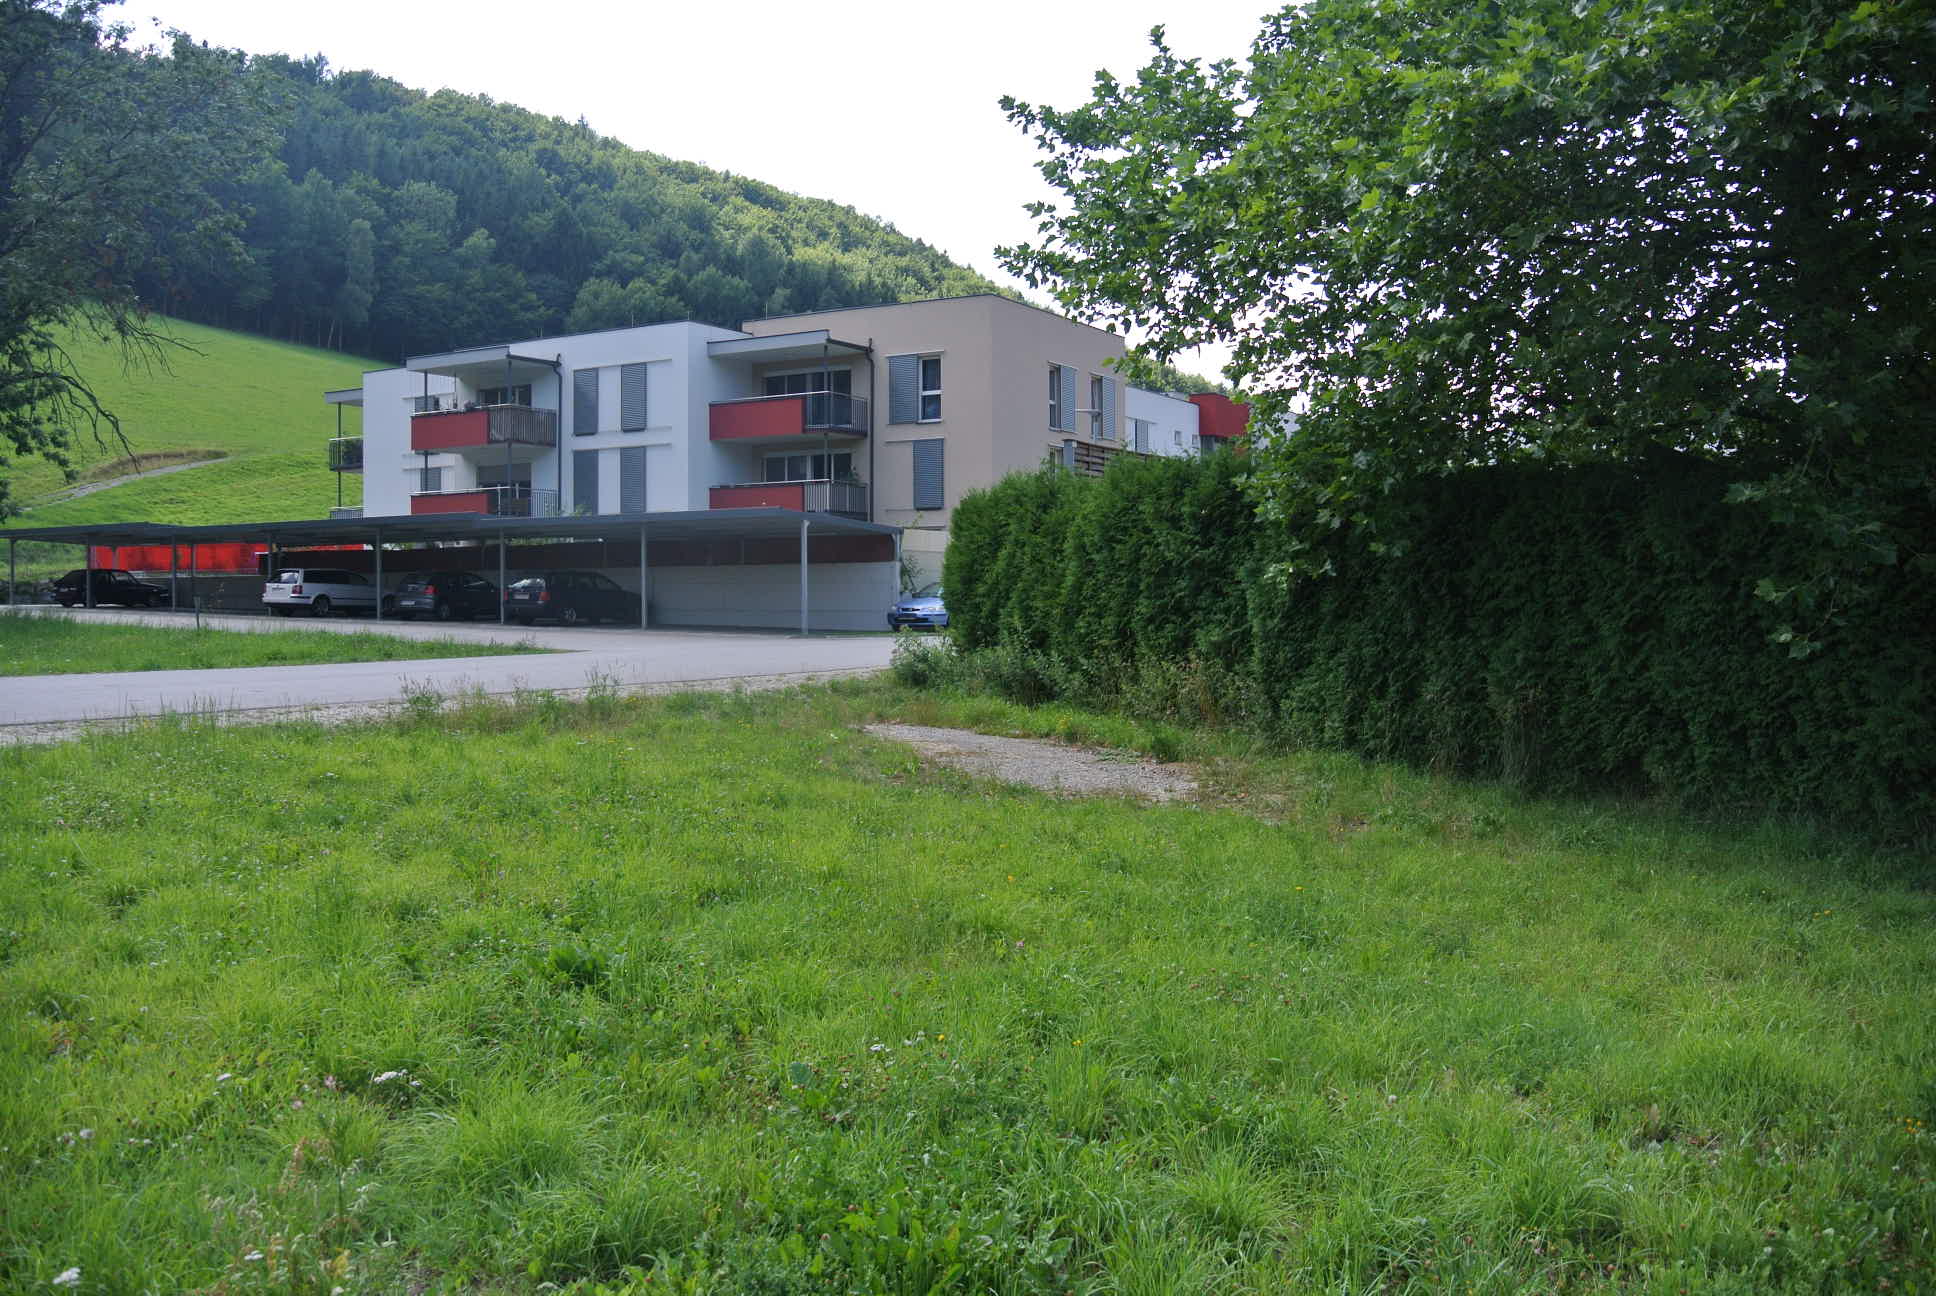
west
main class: Grassland
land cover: Grassland without tree/shrub cover
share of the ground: > 75 %
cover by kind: herbaceous plants 100 %
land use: Abandoned areas
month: July
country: AT
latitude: 47.6015
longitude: 16.1345
